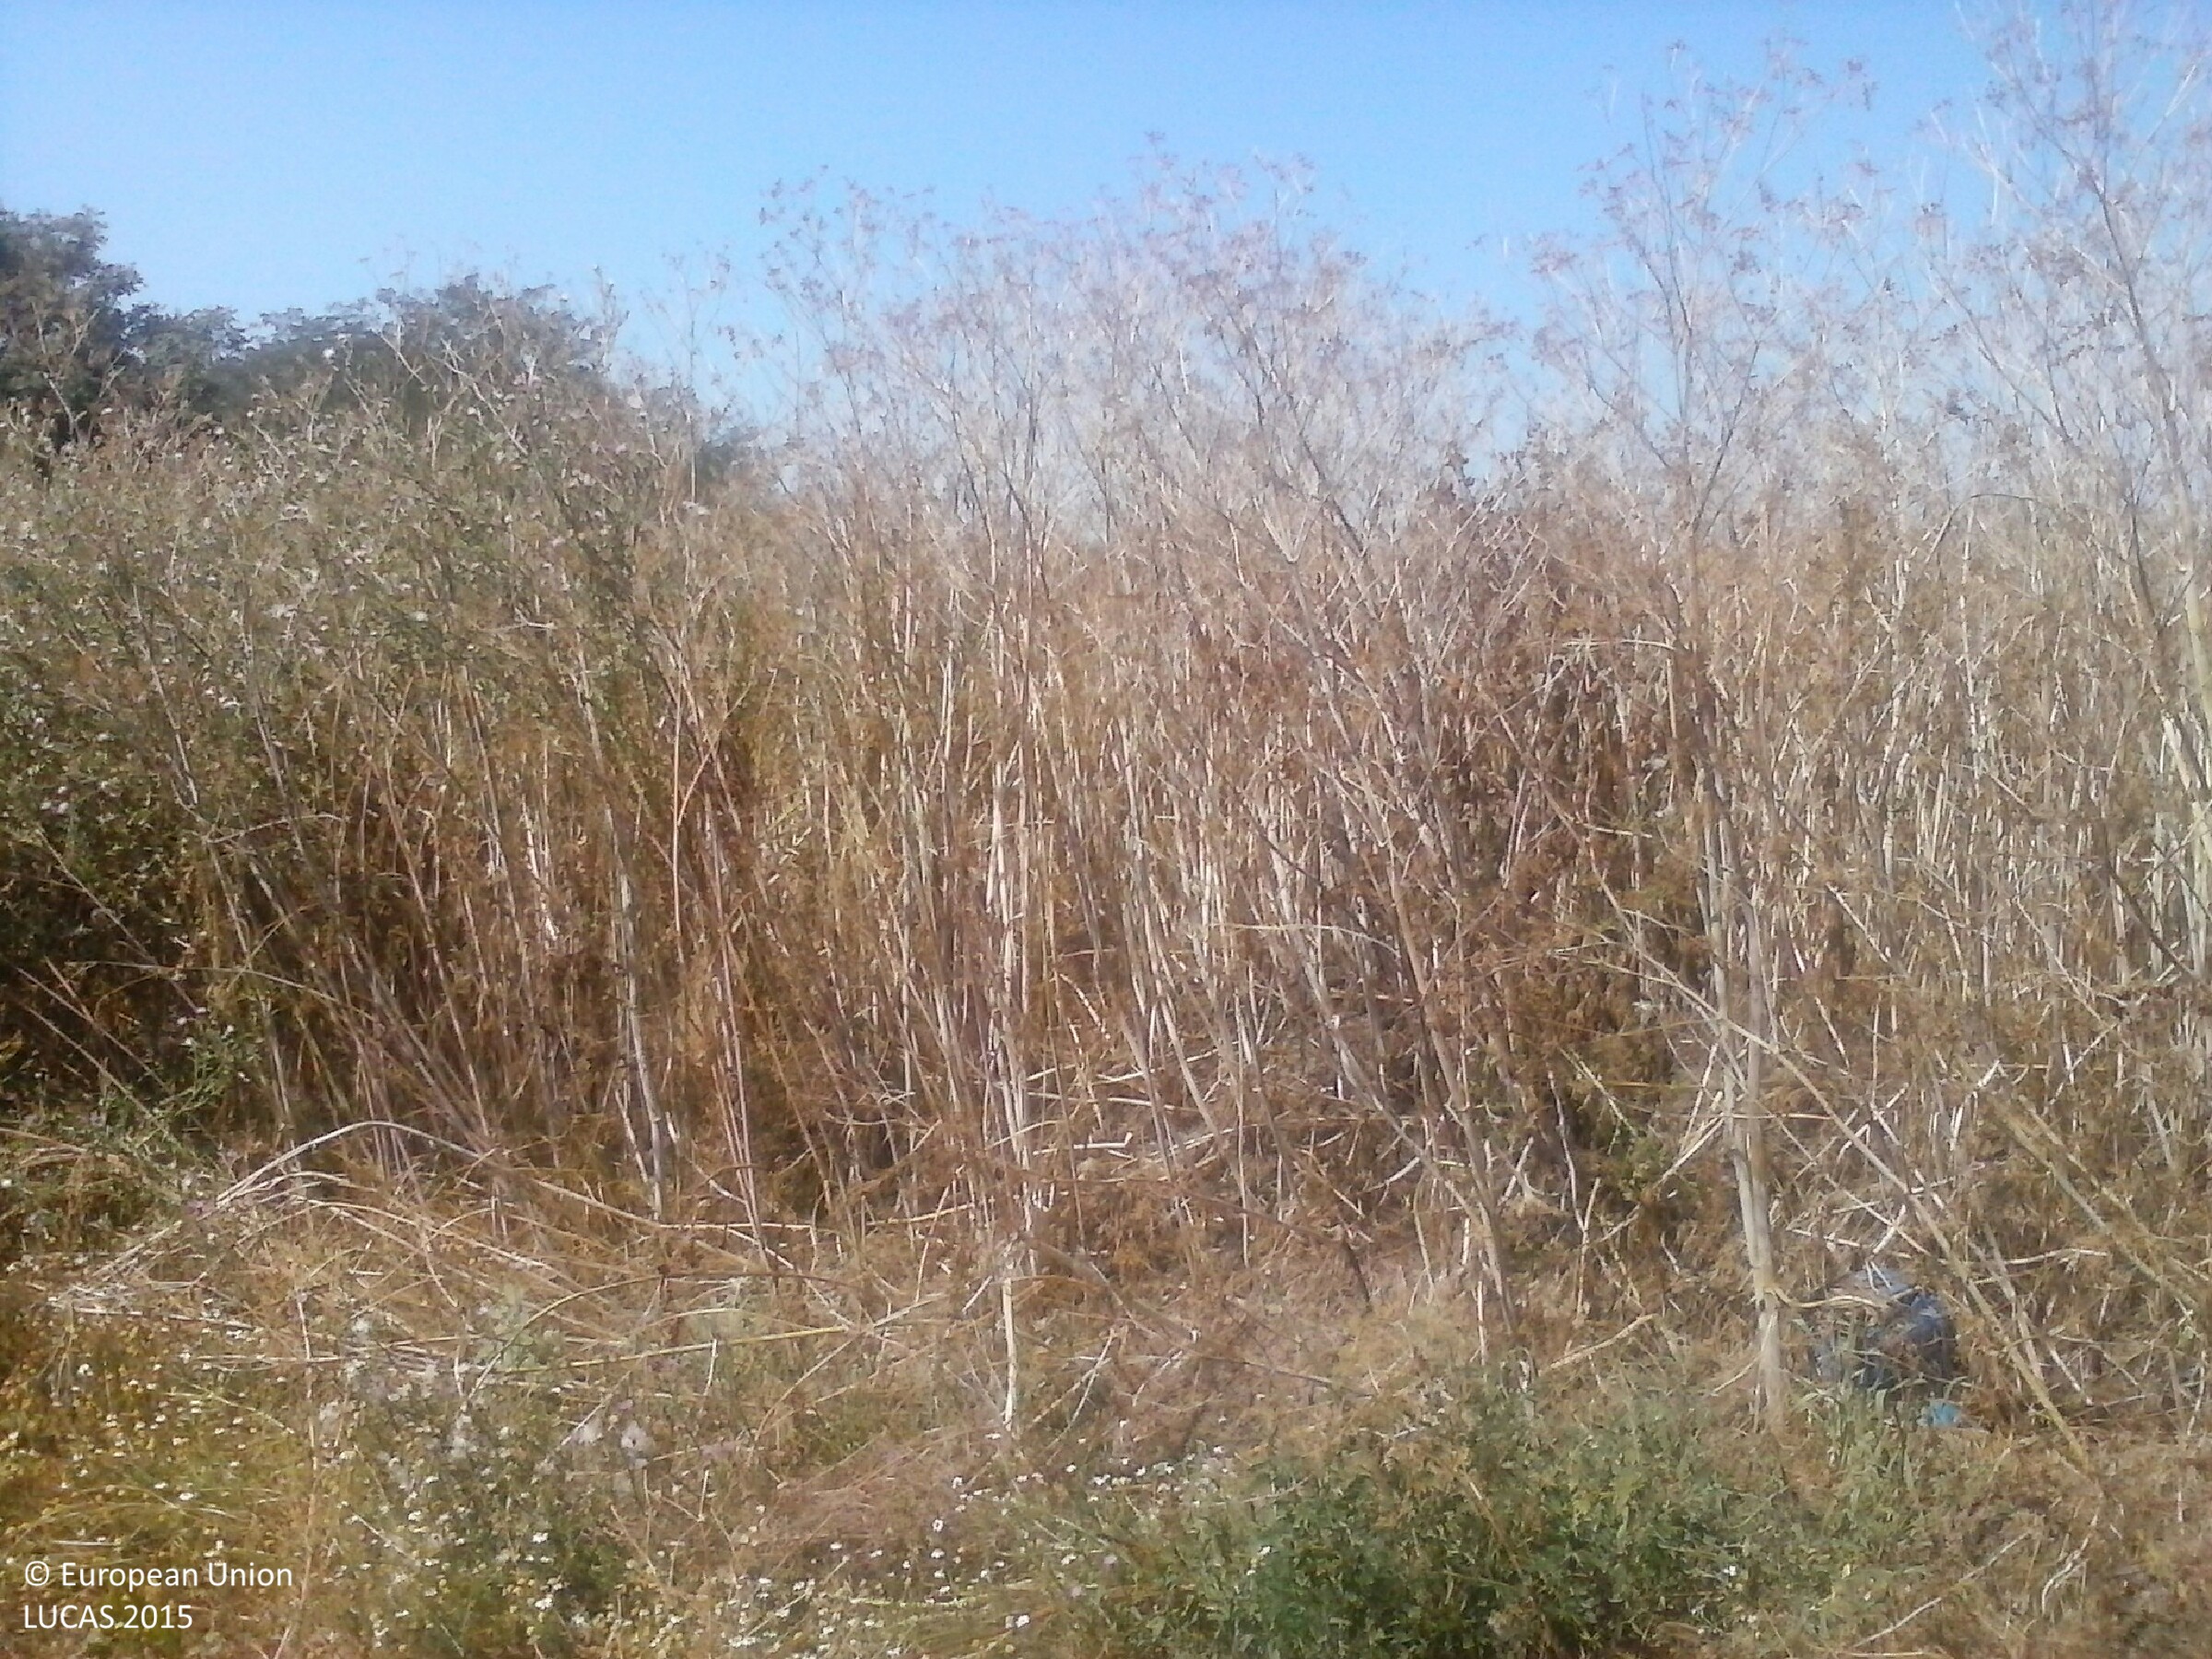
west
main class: Grassland
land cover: Spontaneously vegetated surfaces
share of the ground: 50 - 75 %
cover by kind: herbaceous plants 70 %, unconsolidated bare surface 30 %
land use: Abandoned areas
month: July
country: HU
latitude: 46.6226
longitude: 20.4086
